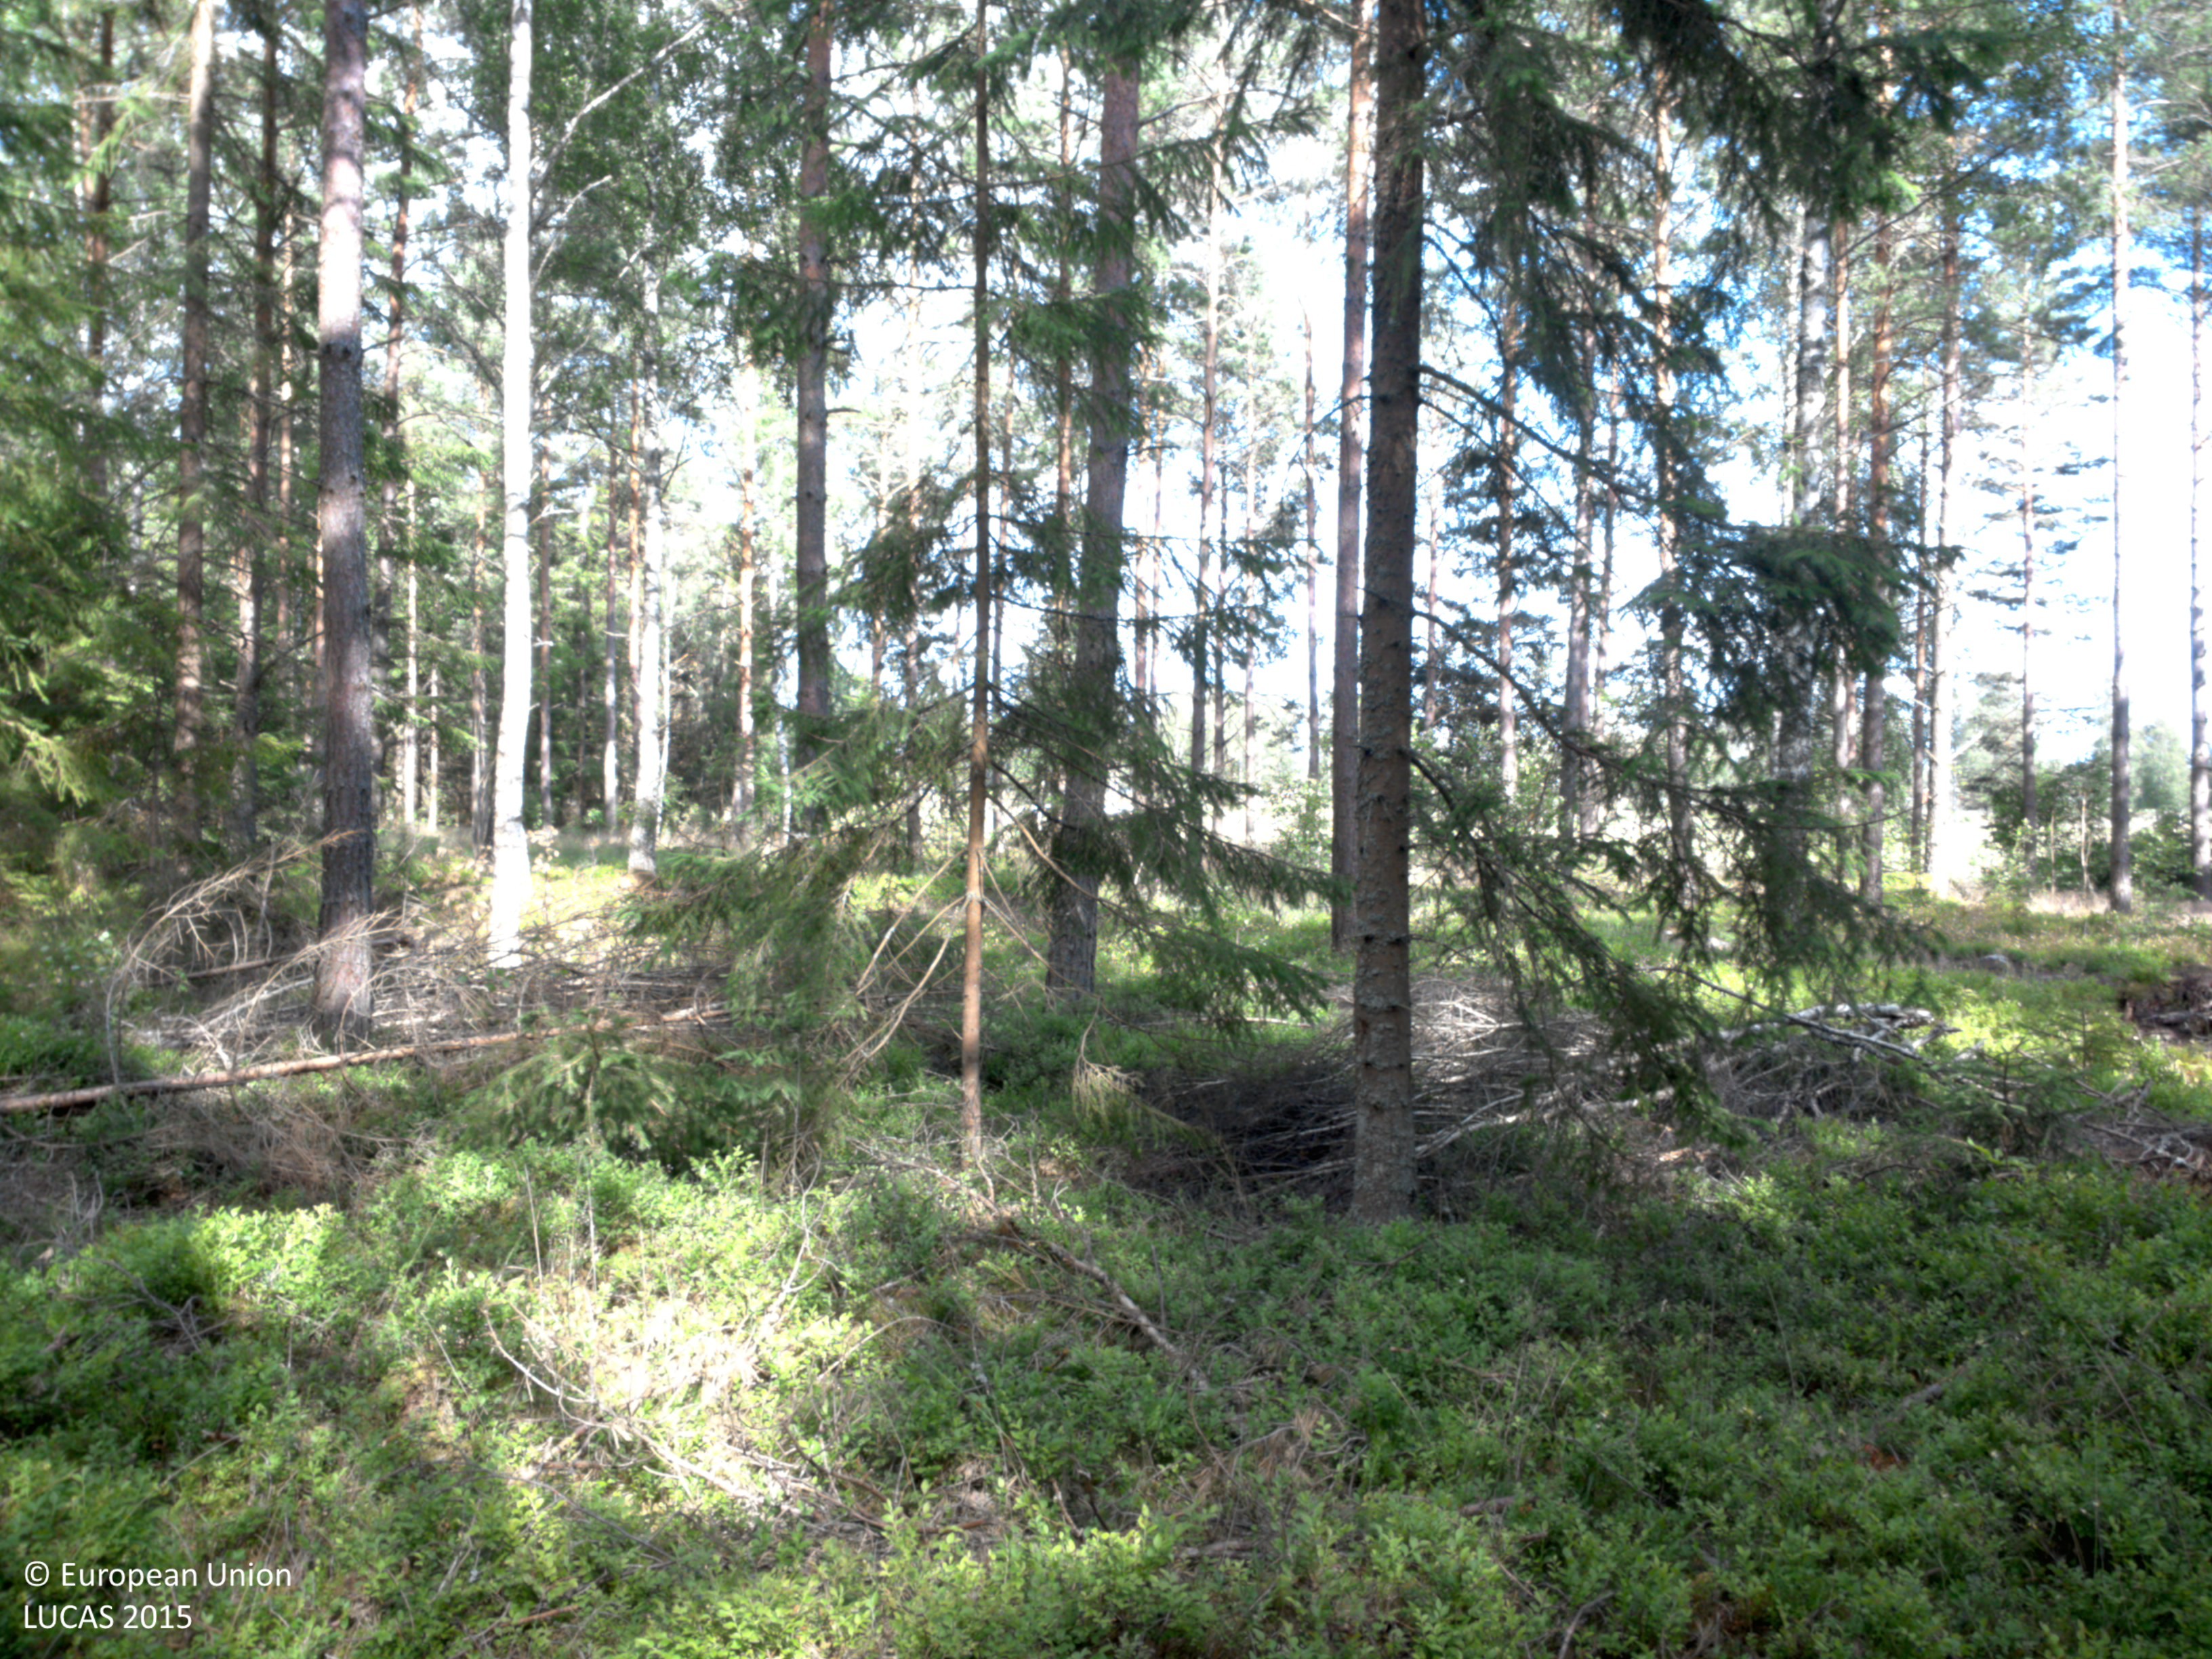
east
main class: Woodland
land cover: Pine dominated coniferous woodland
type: boreal forest
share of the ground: 50 - 75 %
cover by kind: coniferous forest trees 50 %, shrubs 45 %, lichens and mosses 5 %
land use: Forestry
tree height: > 5 m
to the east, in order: Pine dominated coniferous woodland; Tracks; Pine dominated coniferous woodland; Pine dominated mixed woodland; Grassland without tree/shrub cover; Ditches and canals; Grassland with sparse tree/shrub cover; Ditches and canals; Tracks; Fences; Grassland with sparse tree/shrub cover
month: July
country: SE
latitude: 58.2681
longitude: 14.0001
